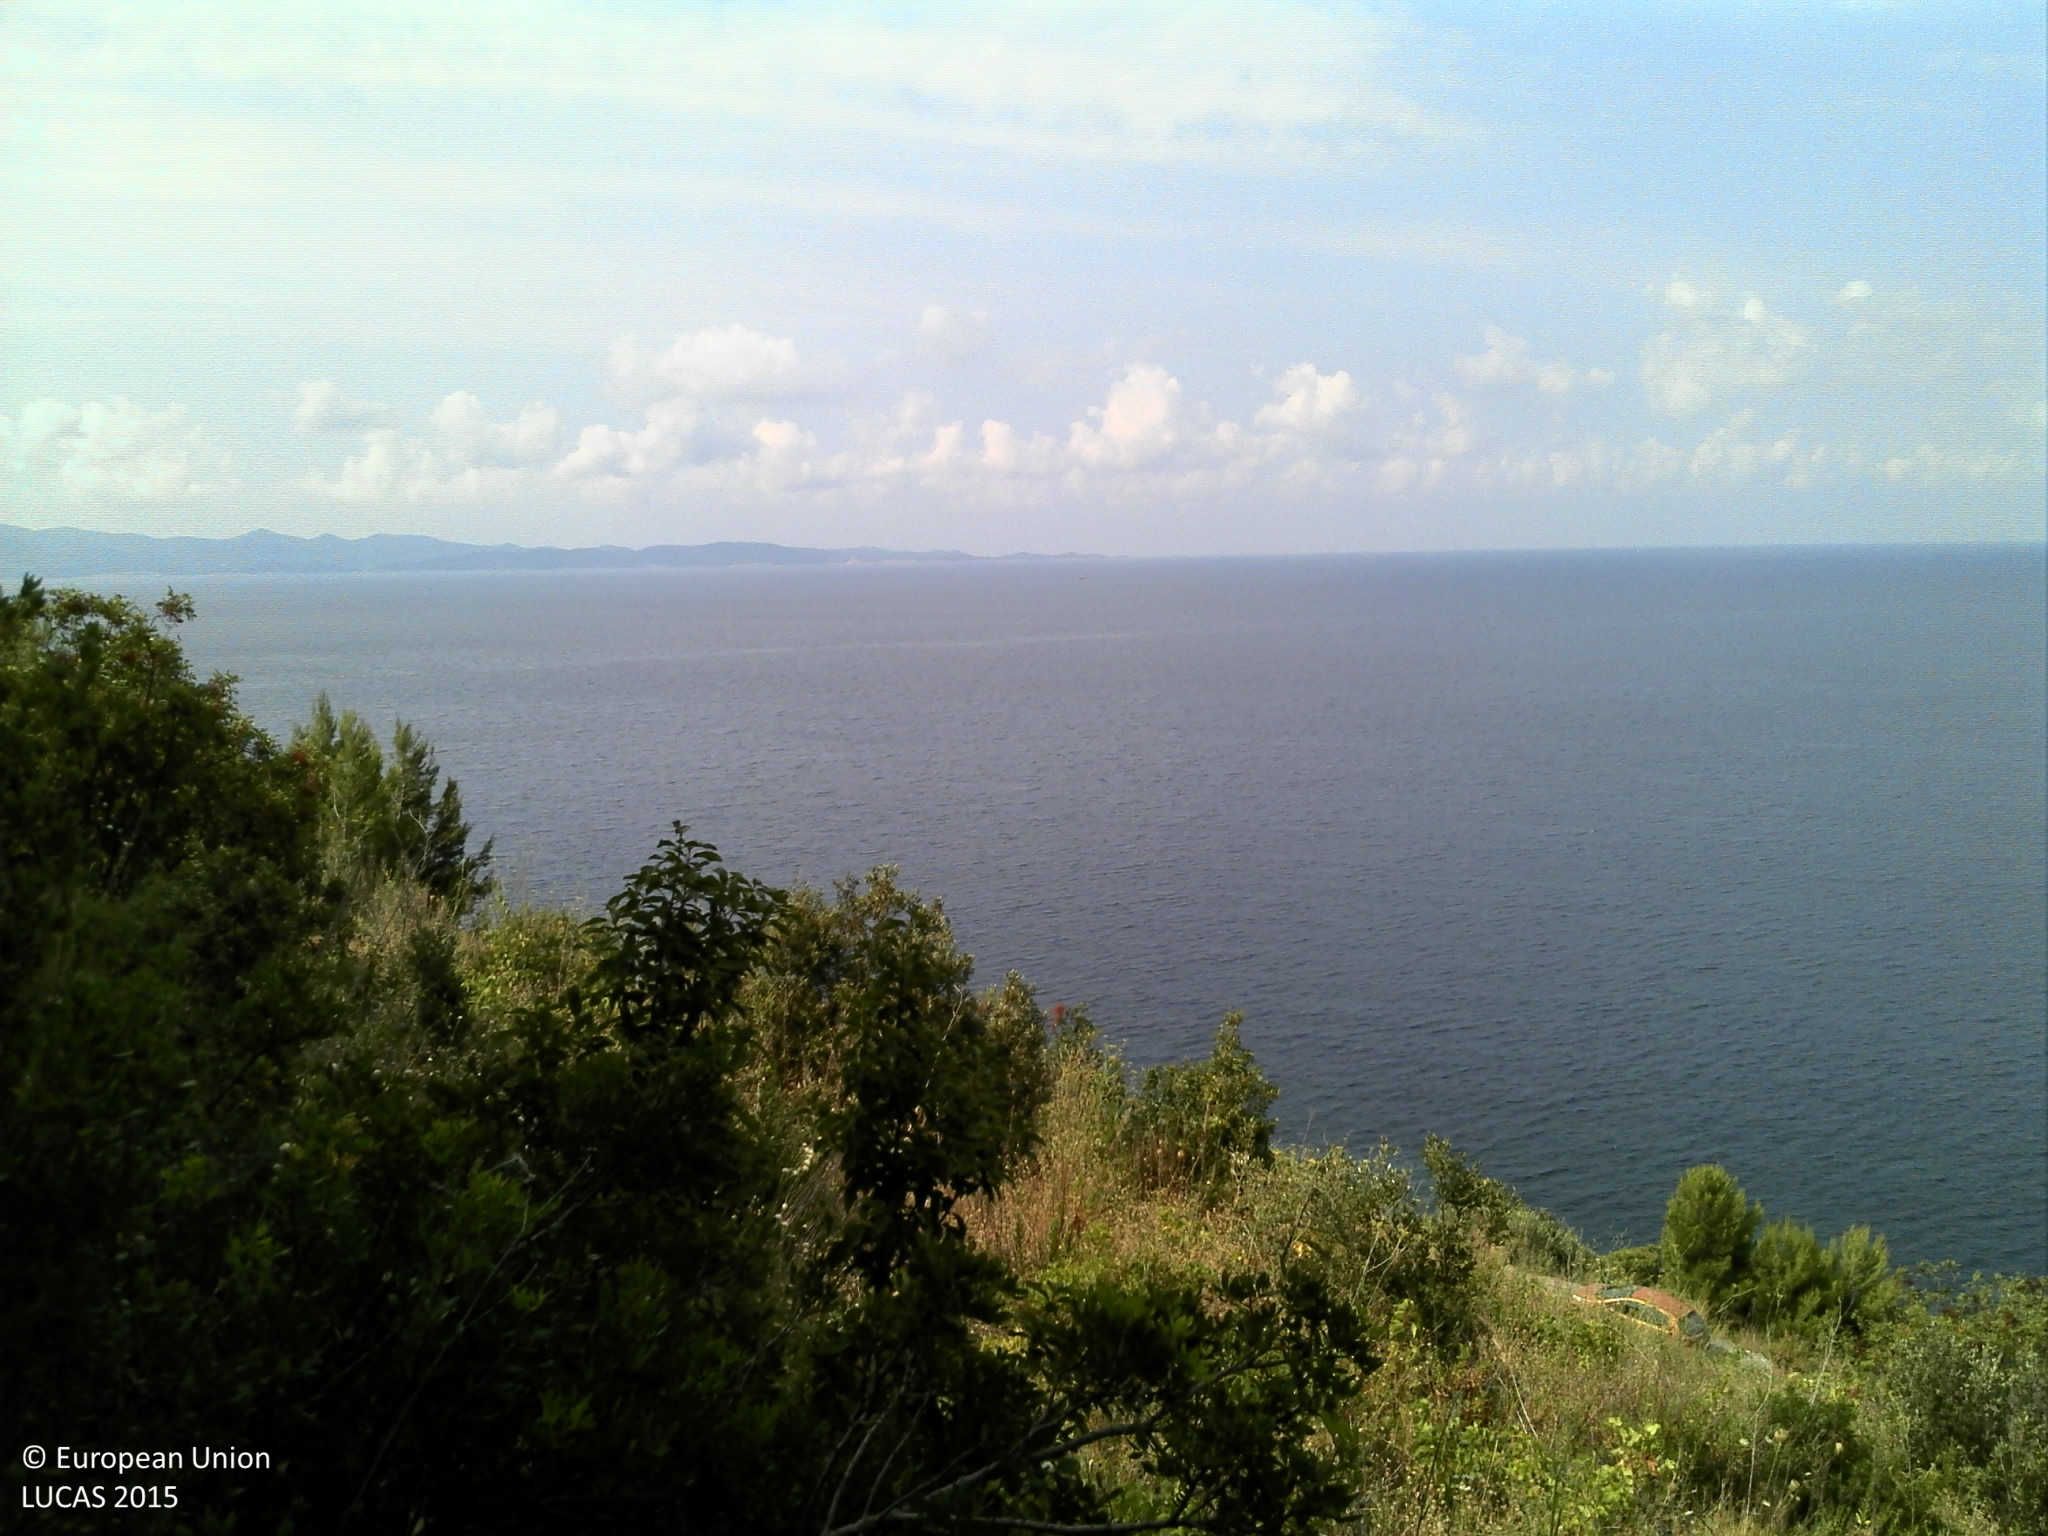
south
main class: Cropland
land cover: Olive groves
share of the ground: 25 - 50 %
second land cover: Vineyards
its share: 10 - 25 %
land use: Agriculture (excluding fallow land and kitchen gardens)
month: July
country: HR
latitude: 42.9069
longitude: 17.4245
